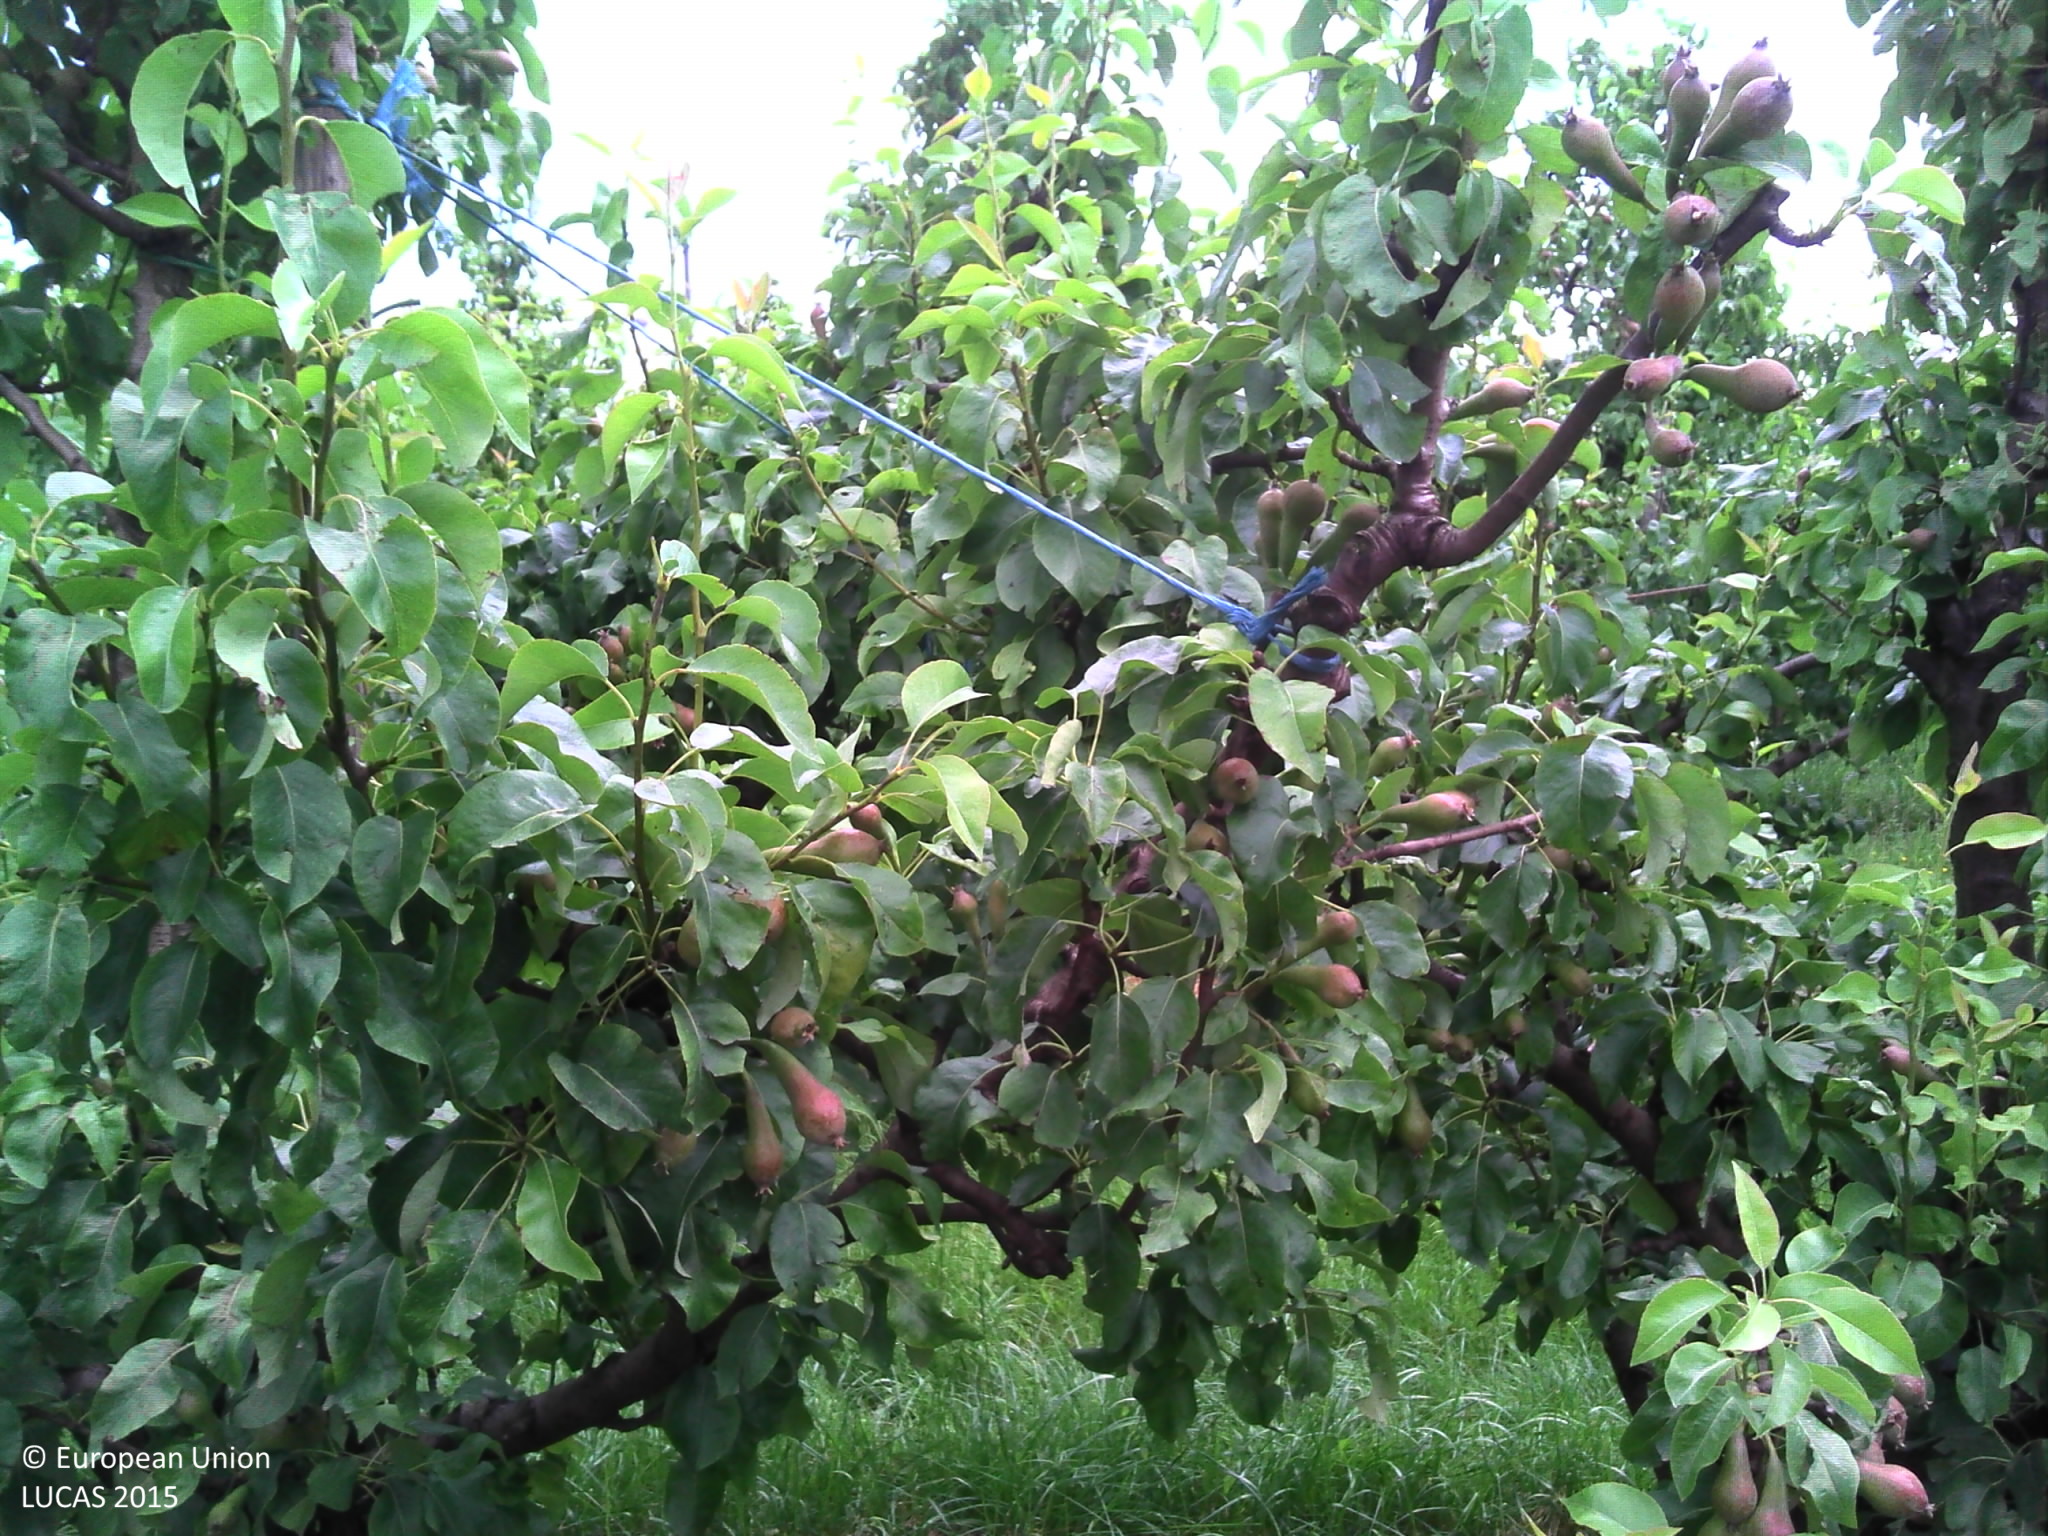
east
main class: Cropland
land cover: Pear fruit
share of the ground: 50 - 75 %
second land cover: Grassland without tree/shrub cover
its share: 25 - 50 %
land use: Agriculture (excluding fallow land and kitchen gardens)
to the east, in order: Pear fruit; Grassland without tree/shrub cover; Grass margins; Ditches and canals; Paved roads, cycling and walking lanes; Grass margins; Ditches and canals; Electric lines; Maize; Ditches and canals; Fences; Grassland without tree/shrub cover
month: June
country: BE
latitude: 51.1753
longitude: 4.2592
